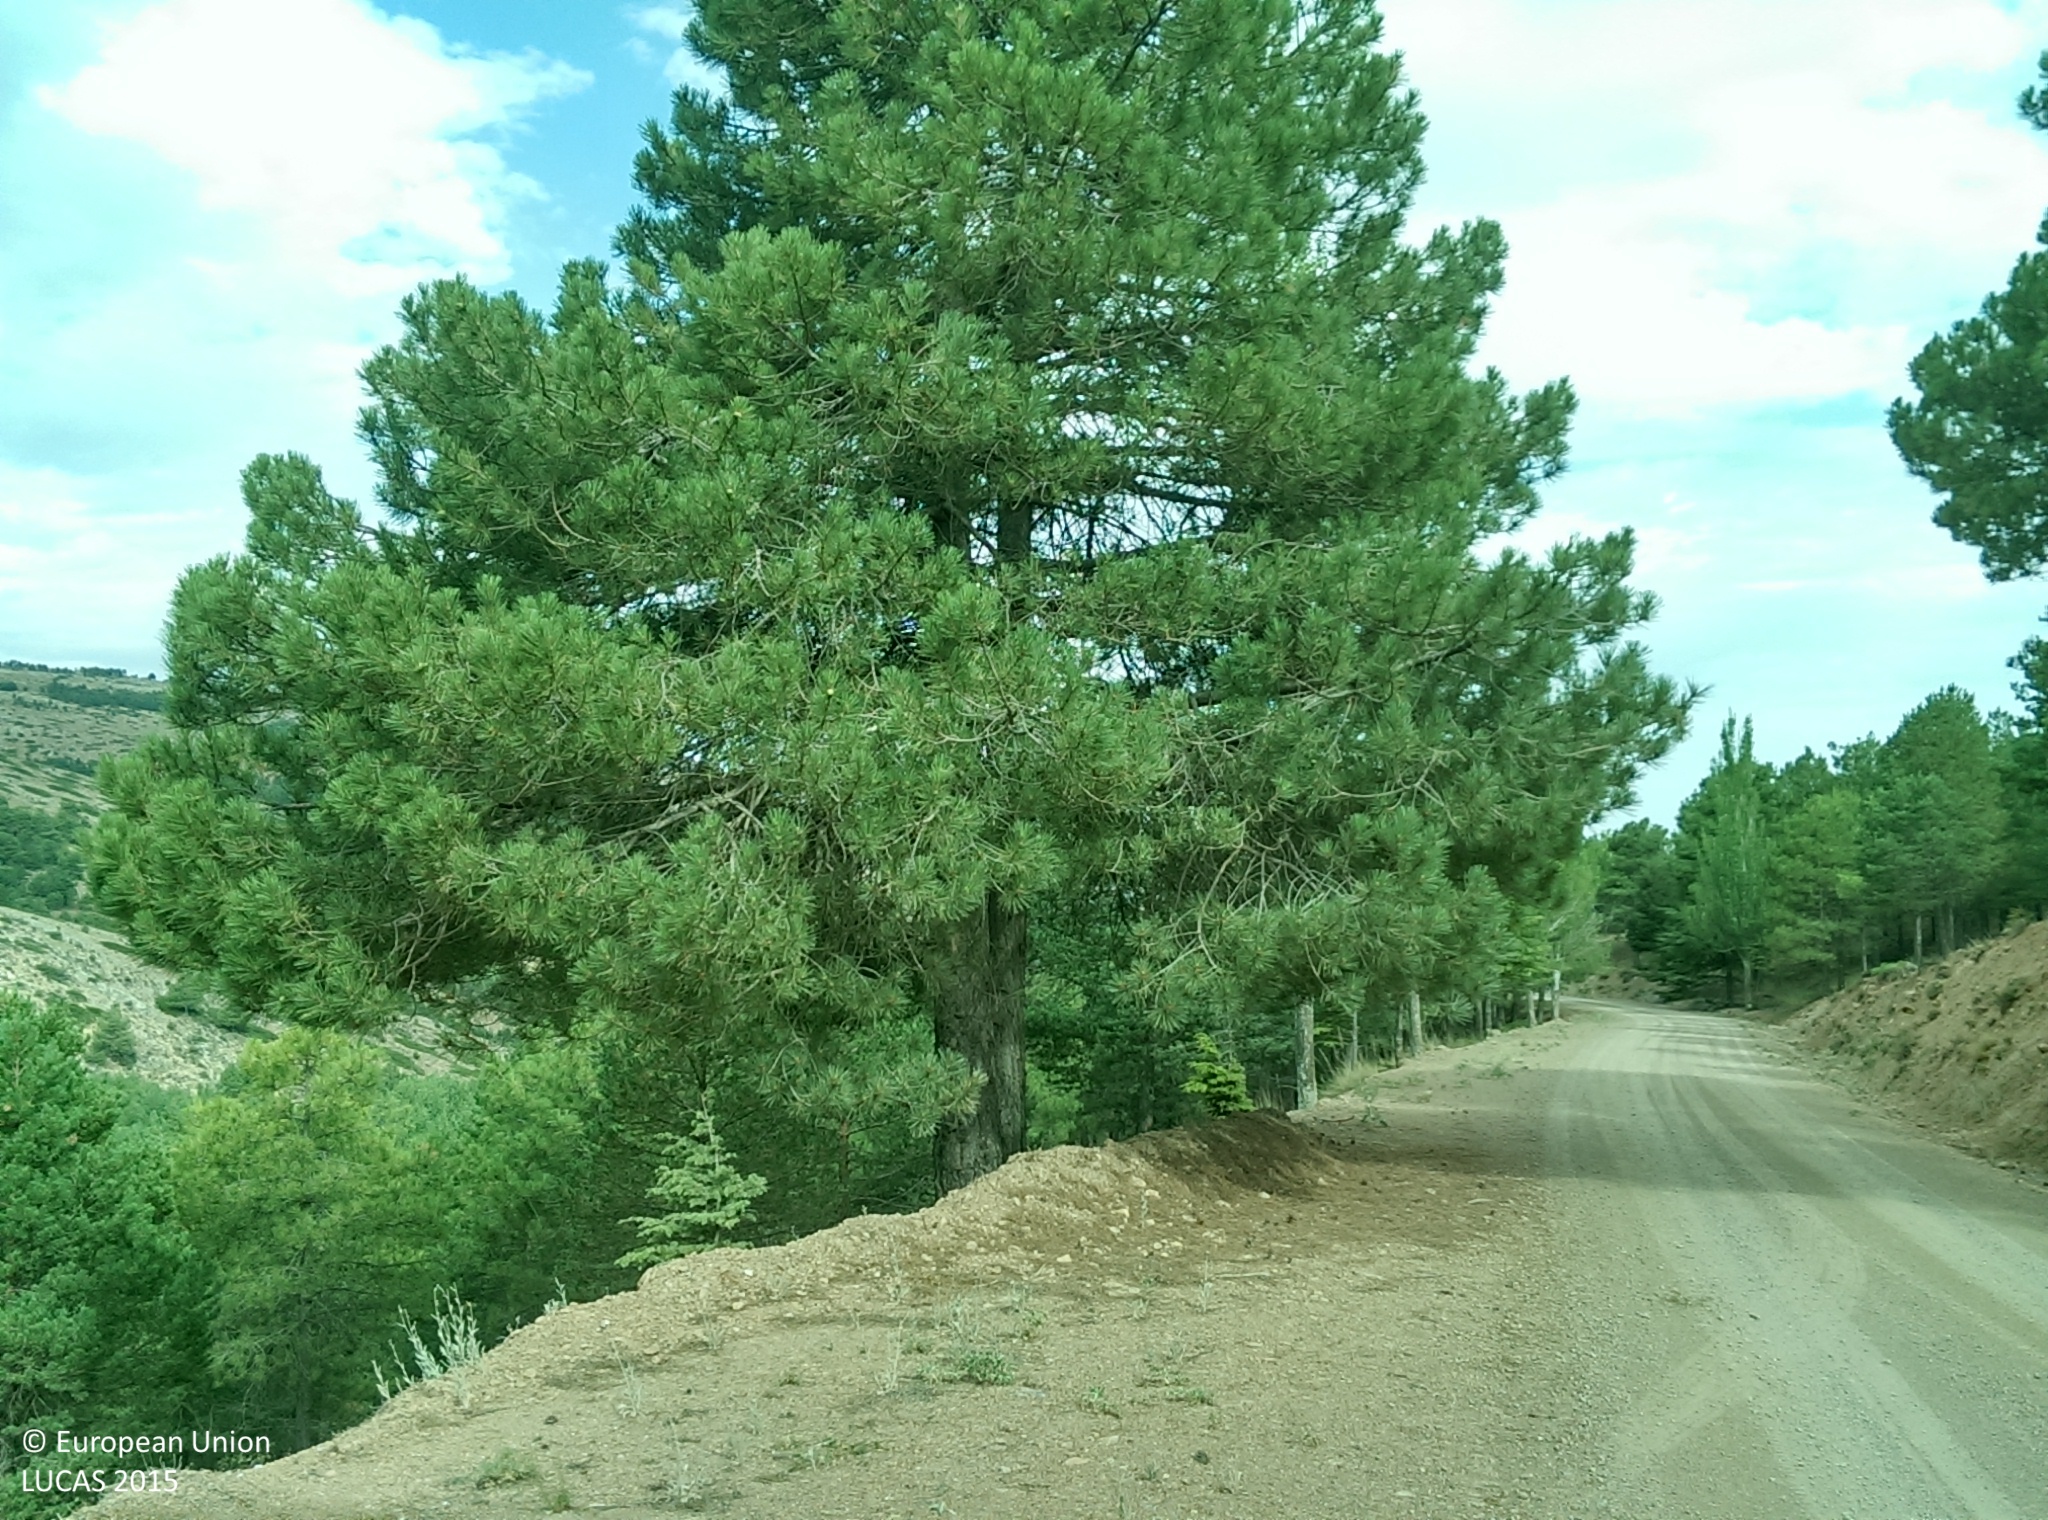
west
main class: Woodland
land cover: Pine dominated coniferous woodland
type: coniferous forest of the mediterranean region
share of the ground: 10 - 25 %
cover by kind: shrubs 40 %, herbaceous plants 20 %, coniferous forest trees 15 %, consolidated bare surface 15 %, unconsolidated bare surface 10 %
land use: Forestry
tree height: > 5 m
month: July
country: ES
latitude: 37.3077
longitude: -2.8812
